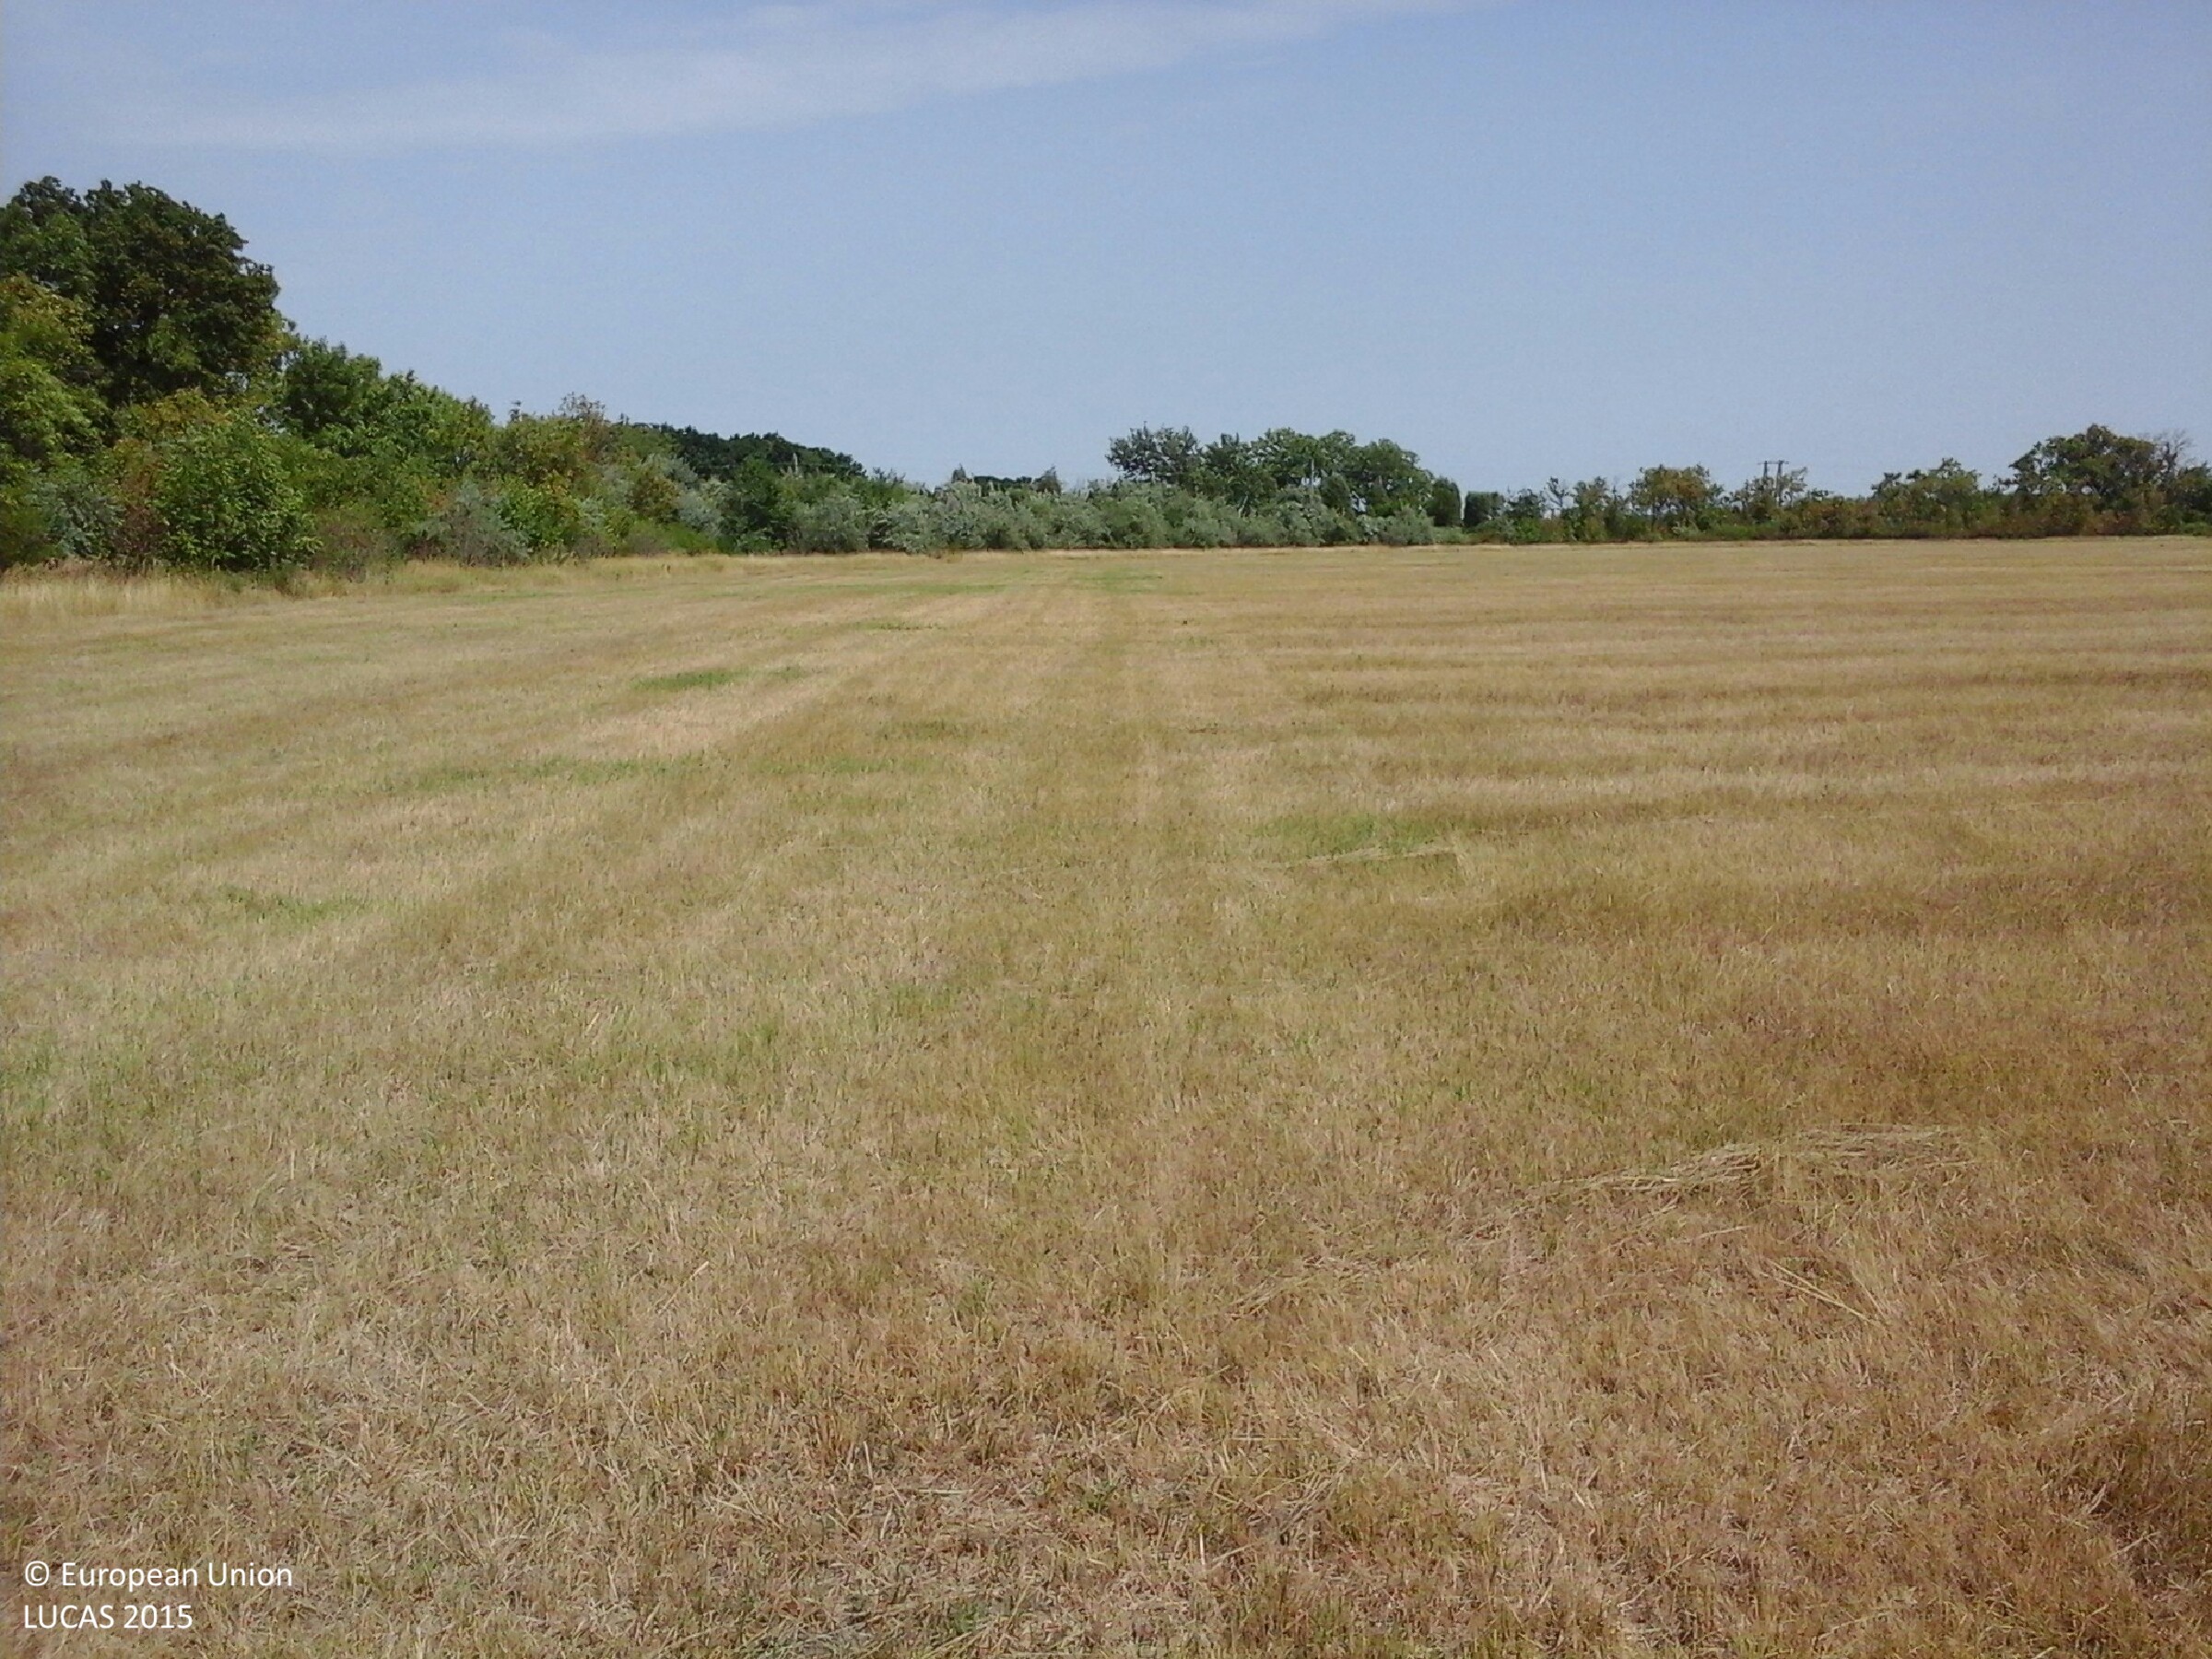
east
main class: Grassland
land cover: Grassland without tree/shrub cover
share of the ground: > 75 %
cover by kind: herbaceous plants 100 %
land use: Agriculture (excluding fallow land and kitchen gardens)
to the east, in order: Grassland without tree/shrub cover; Abandoned hedges; Paved roads, cycling and walking lanes; Grass margins; Ditches and canals; Shrubland without tree cover
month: July
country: HU
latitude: 47.4566
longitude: 20.6036
